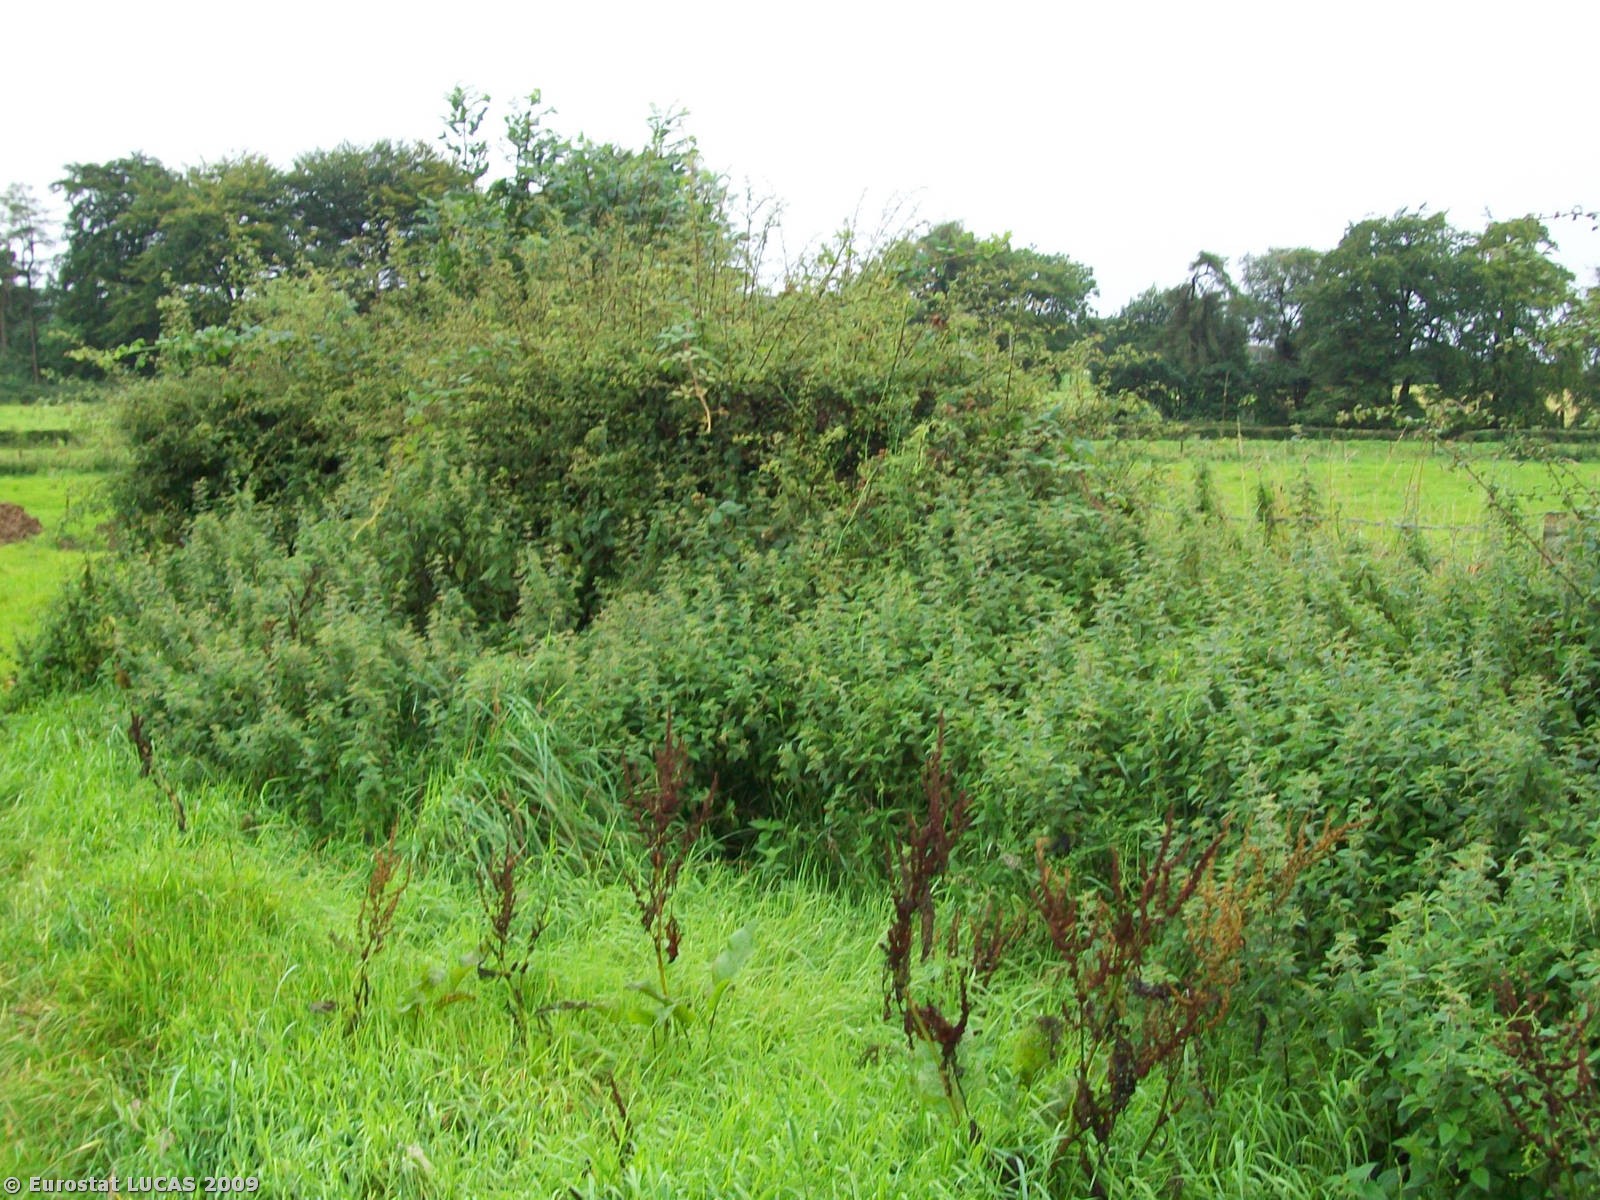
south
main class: Grassland
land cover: Grassland without tree/shrub cover
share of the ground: > 75 %
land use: Agriculture (excluding fallow land and kitchen gardens)
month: August
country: GB
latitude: 54.6089
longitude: -6.1061
